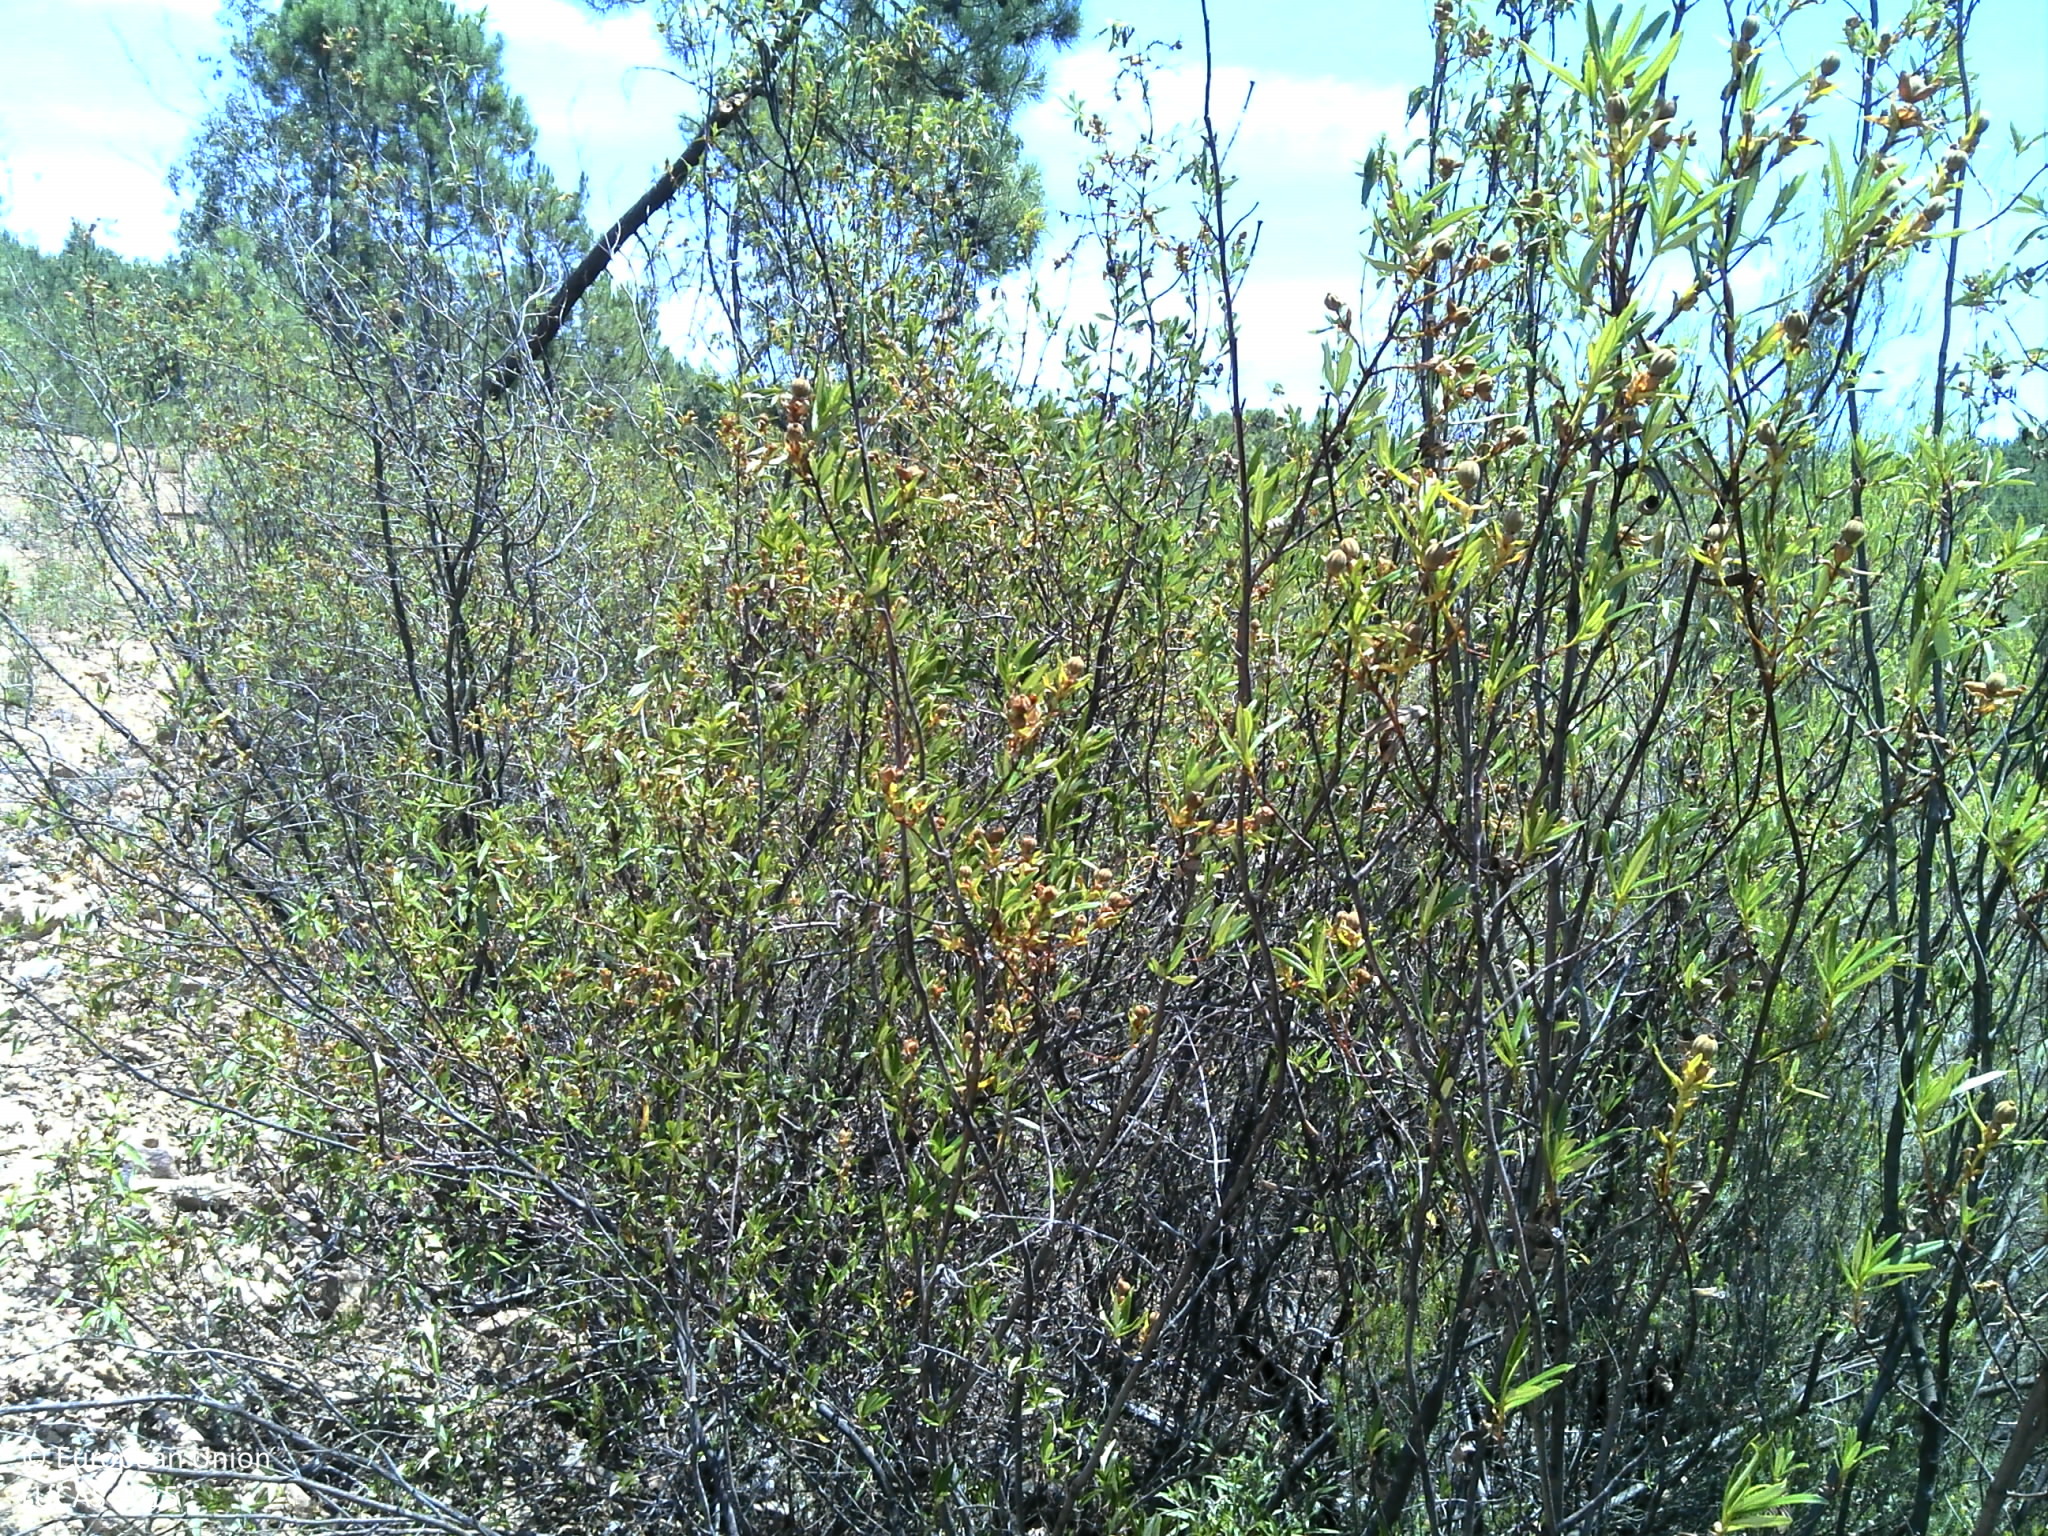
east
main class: Shrubland
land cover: Shrubland with sparse tree cover
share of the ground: > 75 %
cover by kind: shrubs 80 %, unconsolidated bare surface 15 %, coniferous forest trees 5 %
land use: Semi-natural and natural areas not in use
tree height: > 5 m
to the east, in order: Shrubland with sparse tree cover; Tracks; Shrubland without tree cover; Broadleaved woodland; Pine dominated coniferous woodland; Broadleaved woodland; Shrubland without tree cover; Electric lines; Other structural elements; Pine dominated coniferous woodland
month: July
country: PT
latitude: 39.5972
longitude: -7.9347
